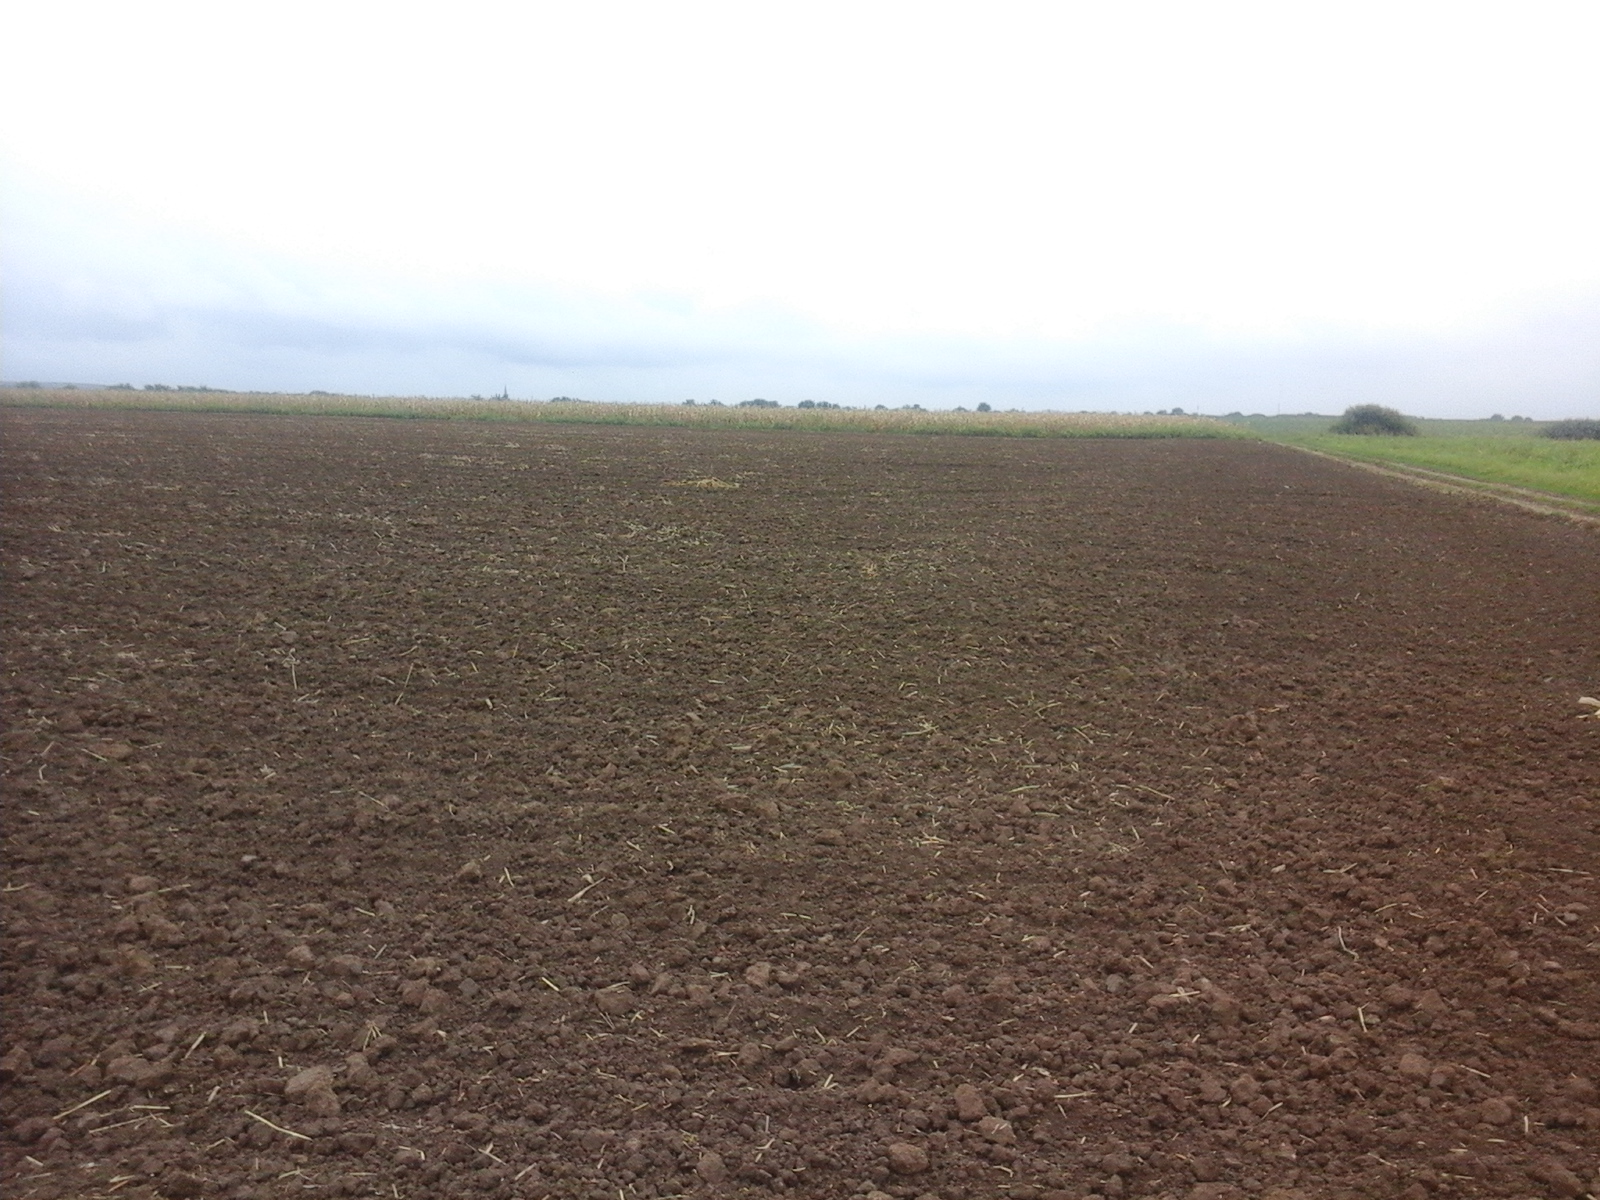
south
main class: Cropland
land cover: Common wheat
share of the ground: < 10 %
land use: Agriculture (excluding fallow land and kitchen gardens)
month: September
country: RO
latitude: 47.1753
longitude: 21.9083
